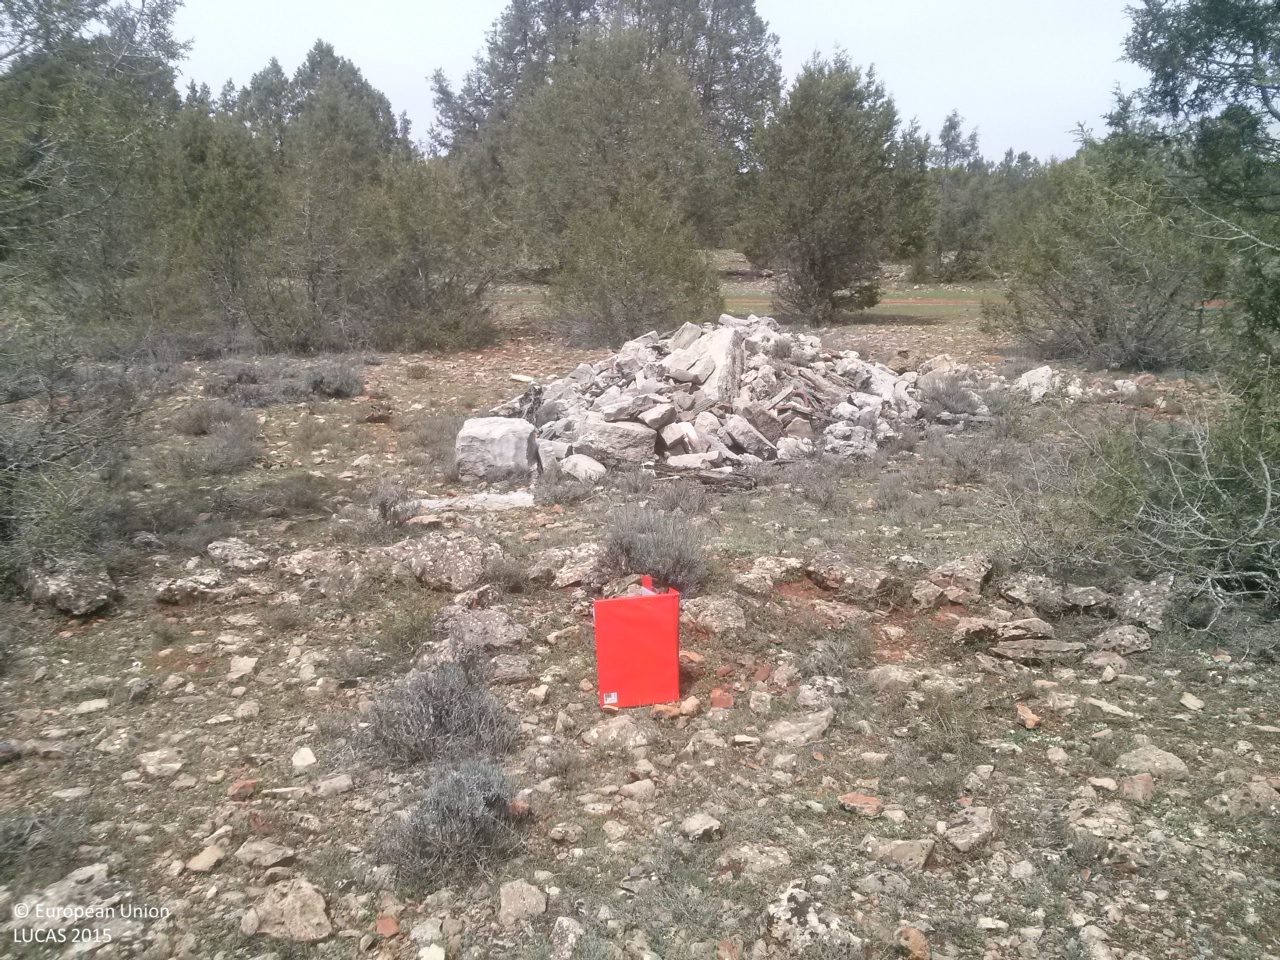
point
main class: Woodland
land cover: Other coniferous woodland
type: coniferous forest of the mediterranean region
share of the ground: 10 - 25 %
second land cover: Grassland without tree/shrub cover
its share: 50 - 75 %
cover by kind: herbaceous plants 60 %, coniferous forest trees 20 %, unconsolidated bare surface 15 %, shrubs 5 %
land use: Forestry
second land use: Agriculture (excluding fallow land and kitchen gardens)
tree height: > 5 m
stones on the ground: > 50 %
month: April
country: ES
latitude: 40.0410
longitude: -1.8386
